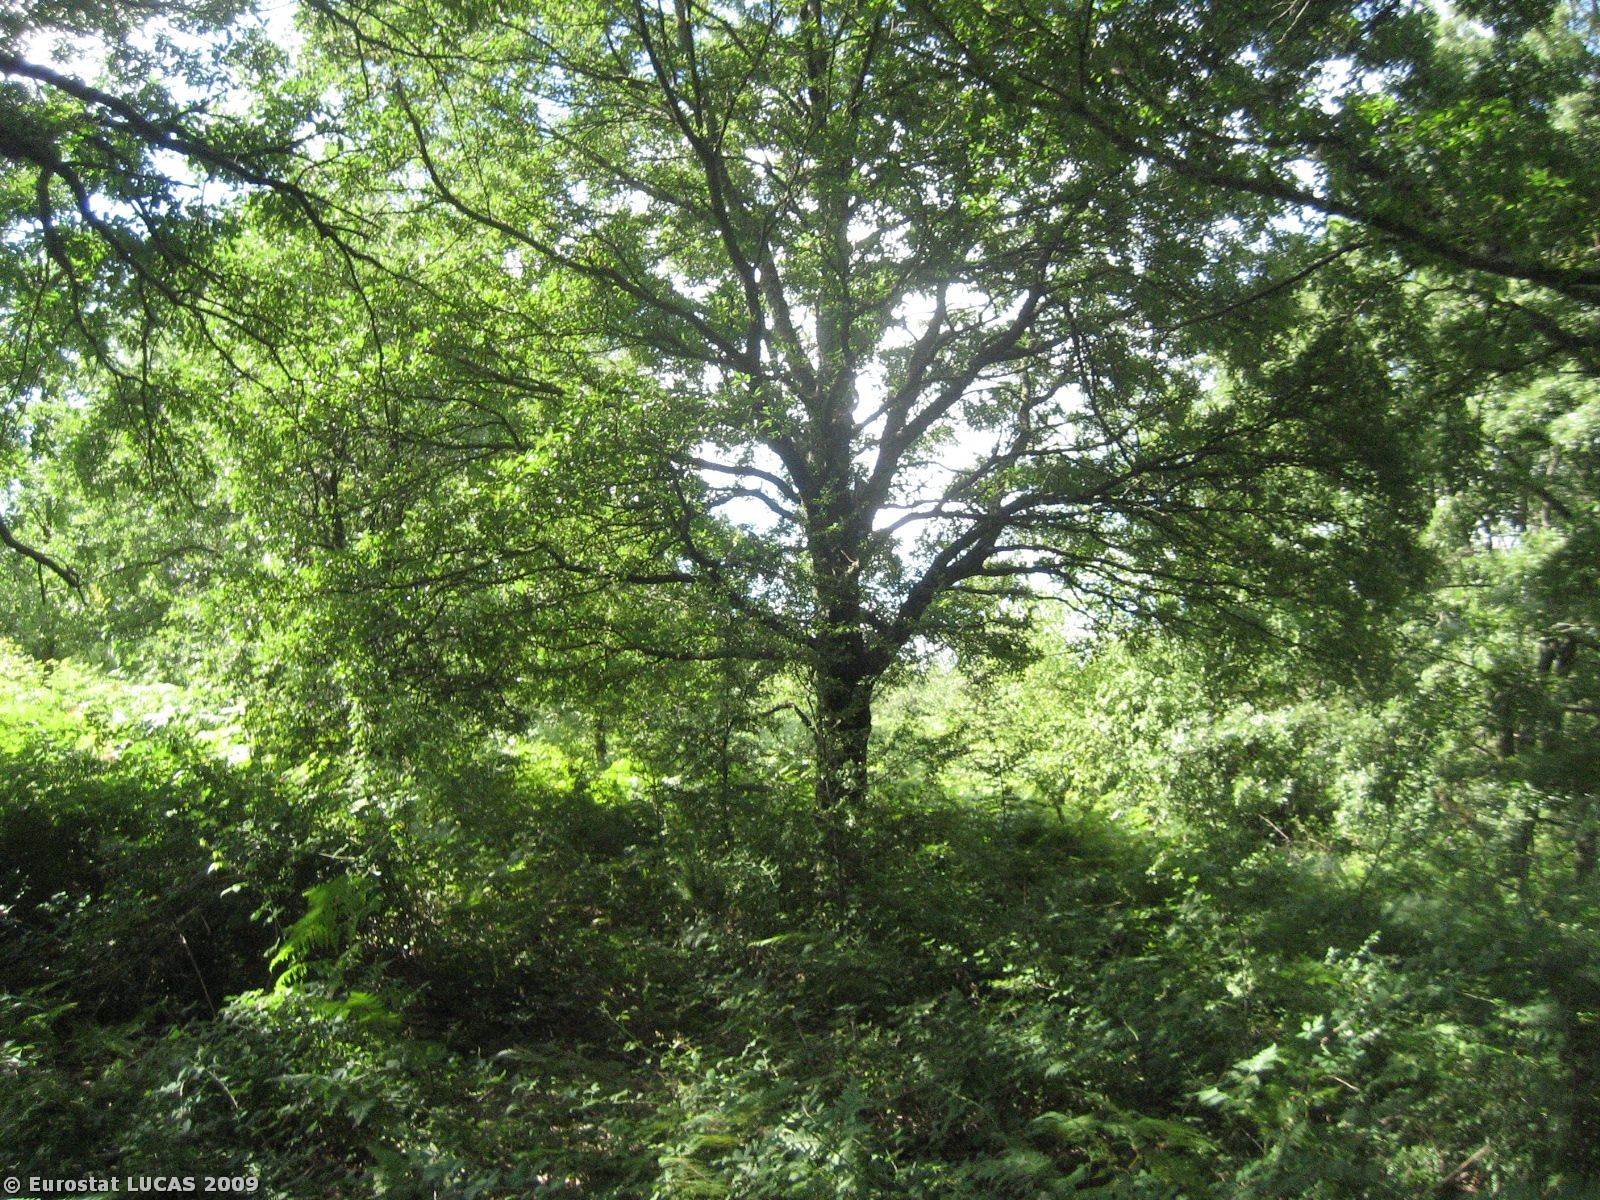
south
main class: Woodland
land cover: Broadleaved woodland
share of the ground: > 75 %
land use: Nature reserves
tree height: < 5 m
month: July
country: IT
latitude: 41.8455
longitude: 15.9449
